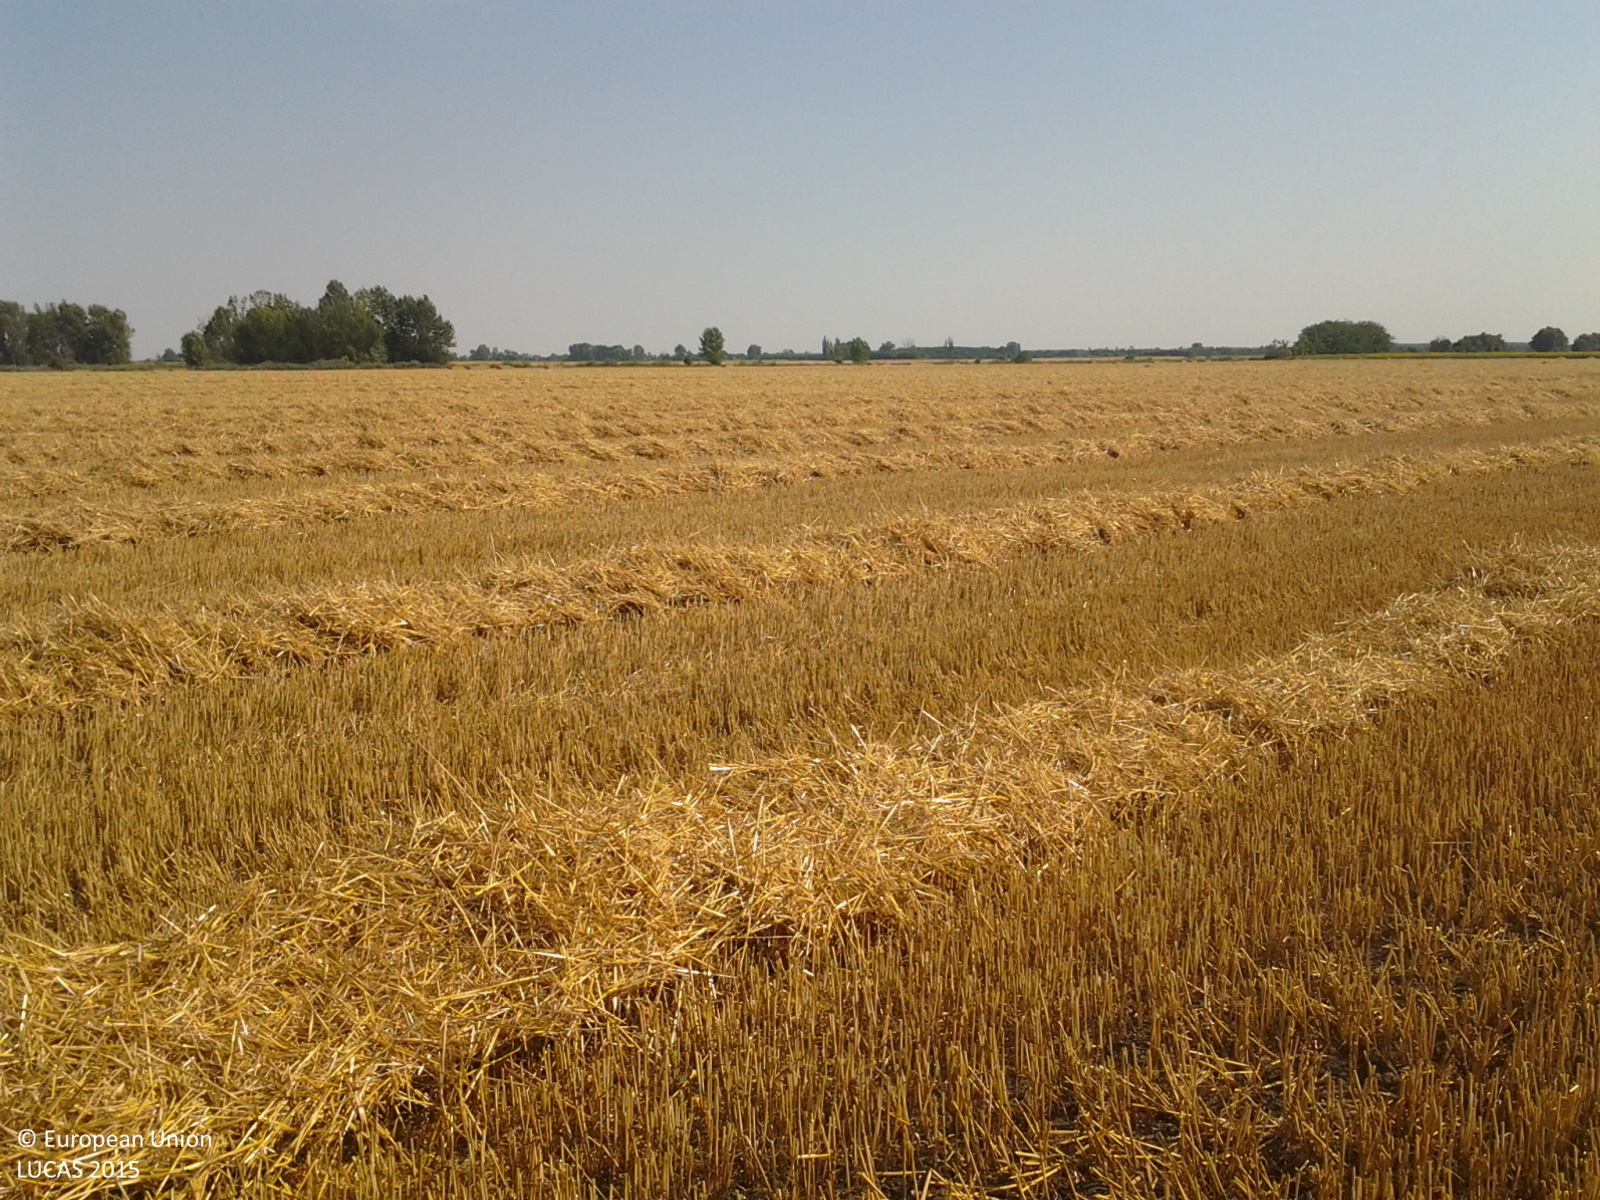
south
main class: Cropland
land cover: Triticale
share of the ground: > 75 %
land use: Agriculture (excluding fallow land and kitchen gardens)
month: July
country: HU
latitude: 47.4654
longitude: 19.9353
